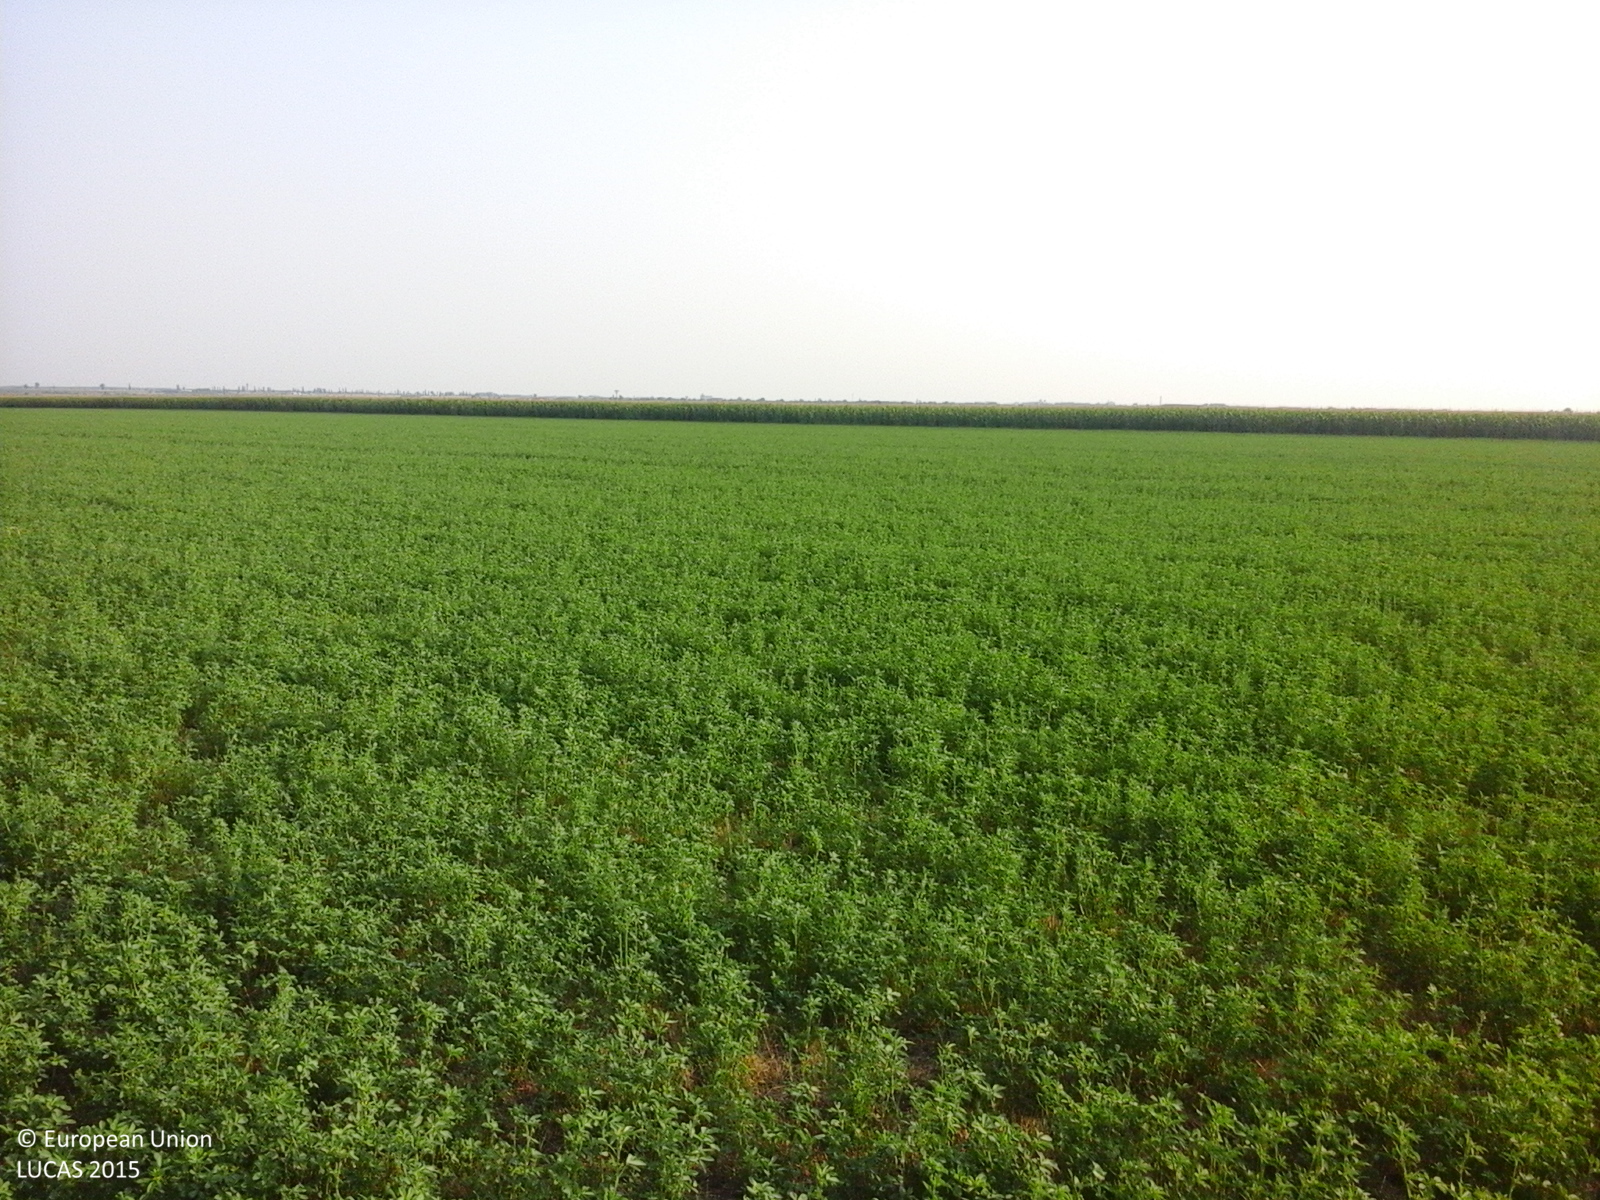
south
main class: Cropland
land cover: Lucerne
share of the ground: > 75 %
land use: Agriculture (excluding fallow land and kitchen gardens)
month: July
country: RO
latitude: 44.5024
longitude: 26.5301
